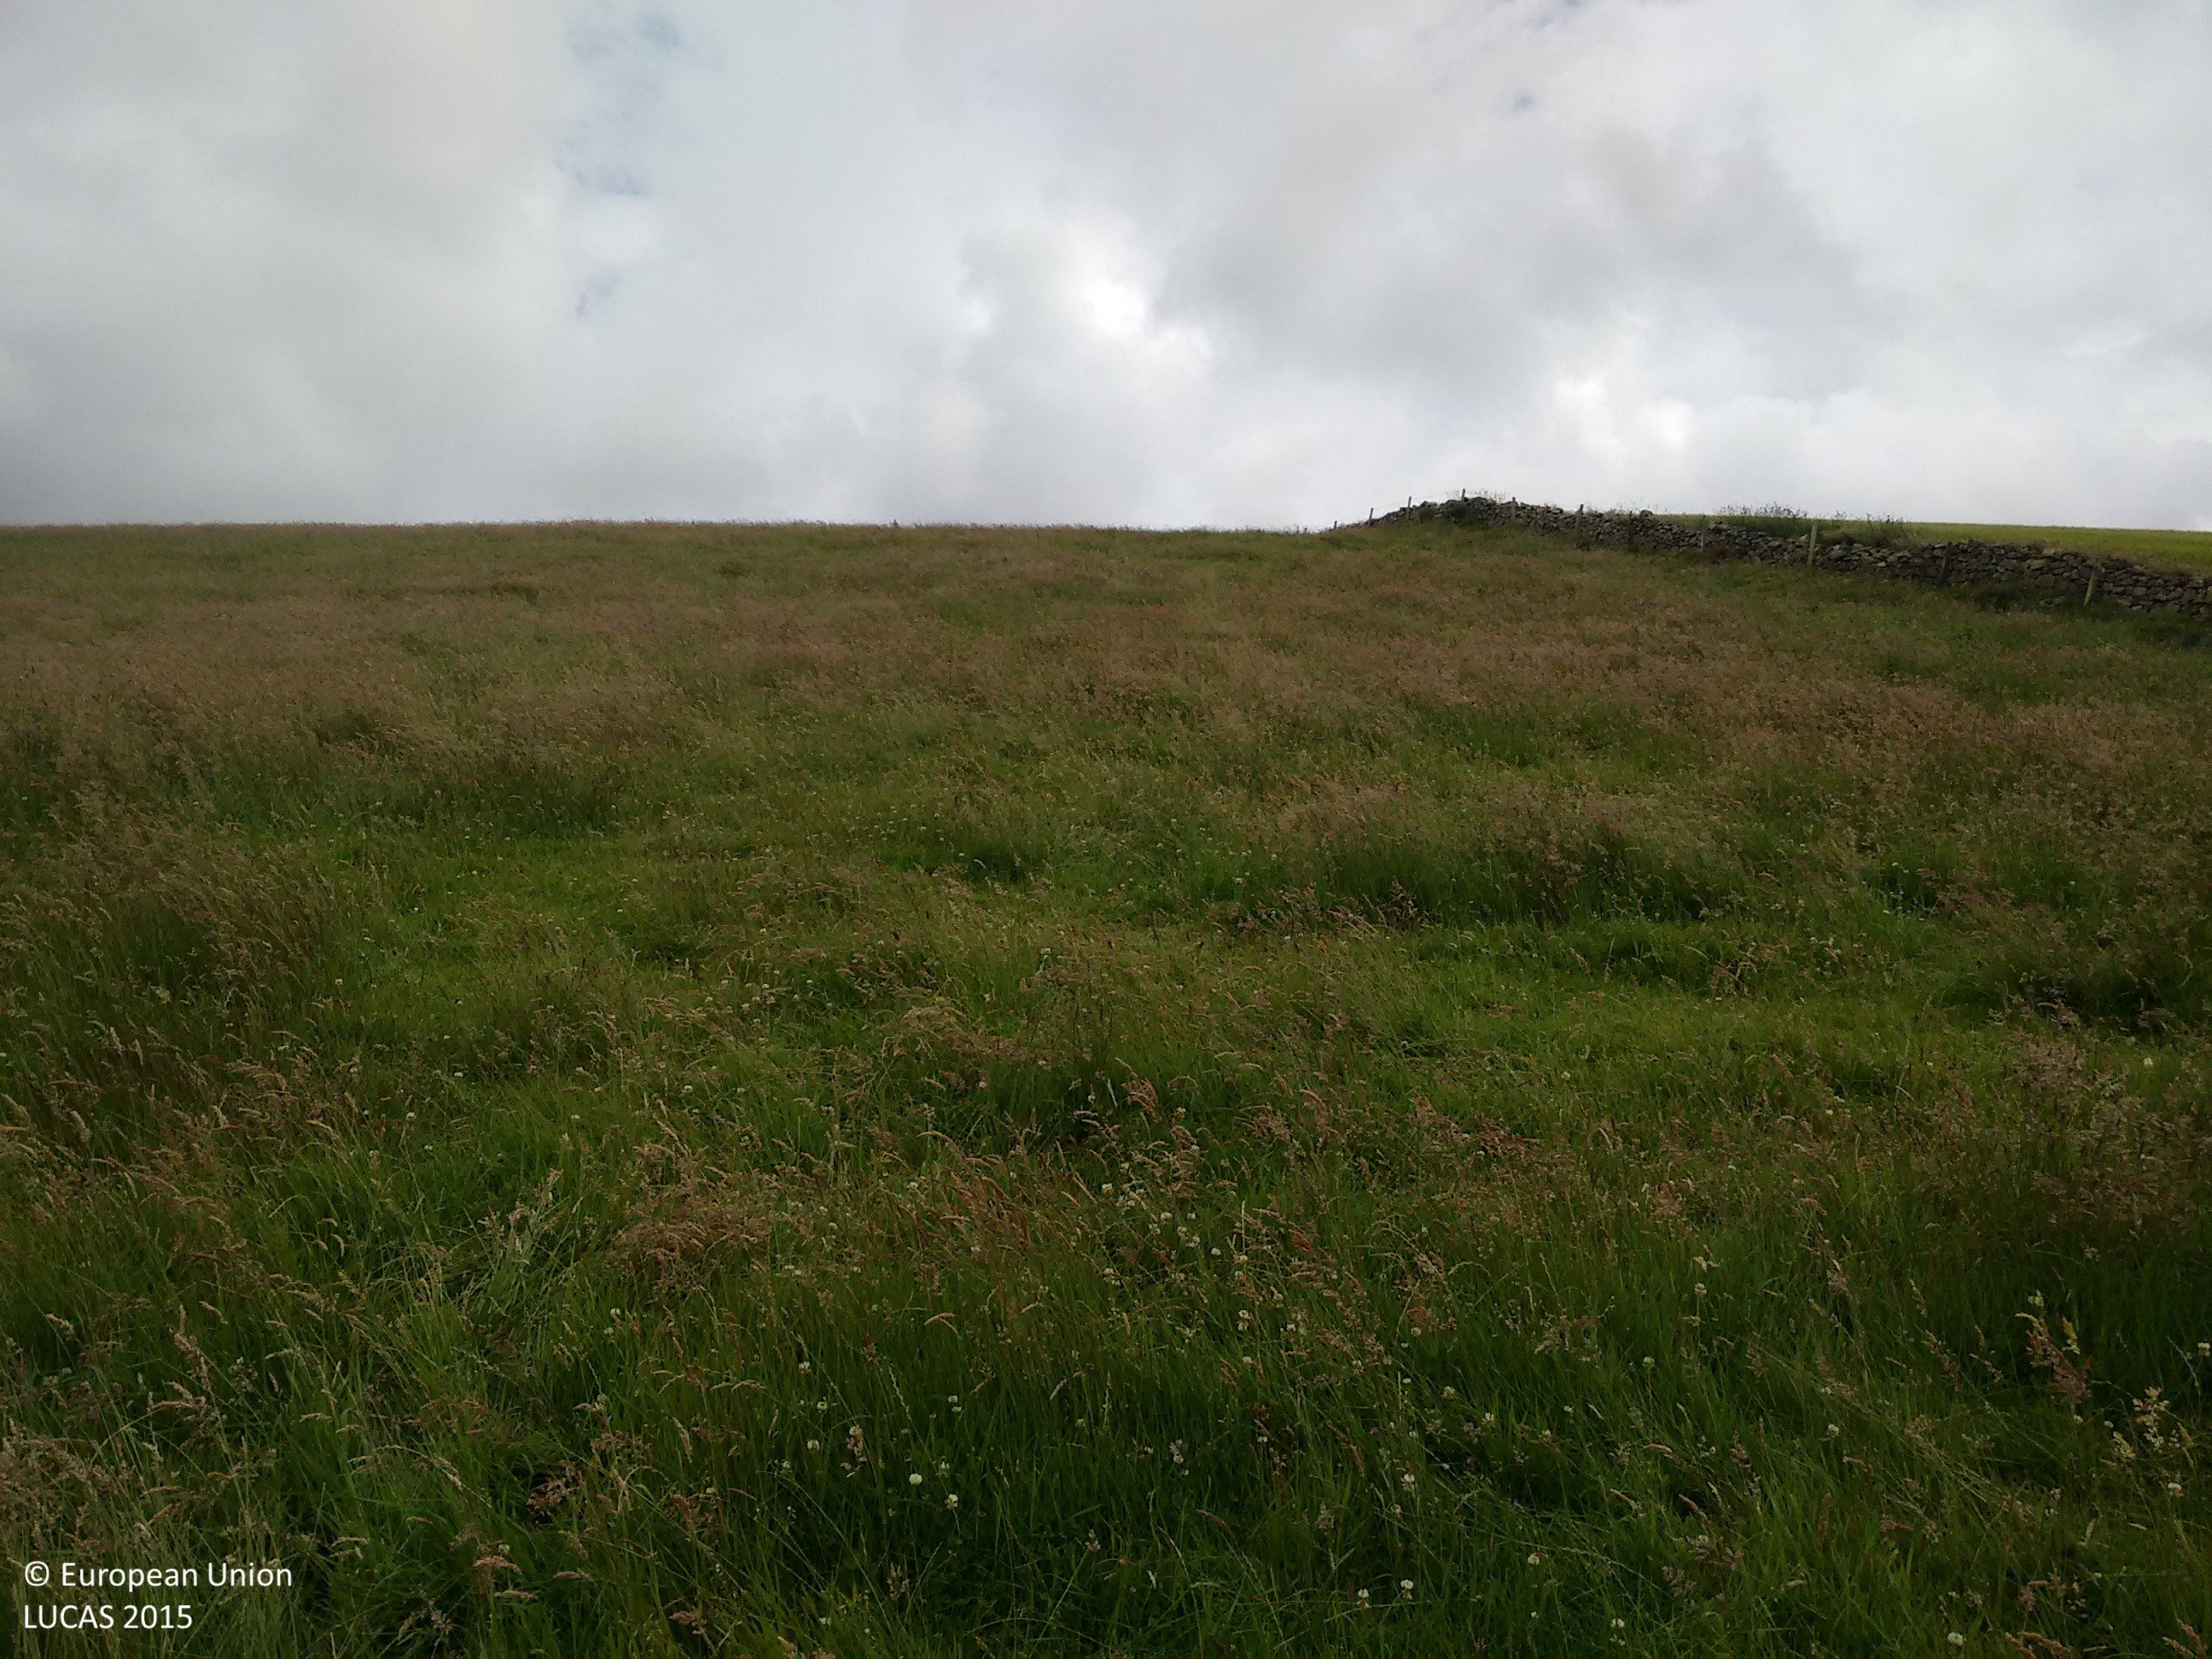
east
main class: Grassland
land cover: Grassland without tree/shrub cover
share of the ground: > 75 %
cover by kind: herbaceous plants 100 %
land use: Agriculture (excluding fallow land and kitchen gardens)
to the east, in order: Grassland without tree/shrub cover; Fences; Dry stone walls; Grass margins; Barley
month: July
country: GB
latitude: 57.3486
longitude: -2.2305
